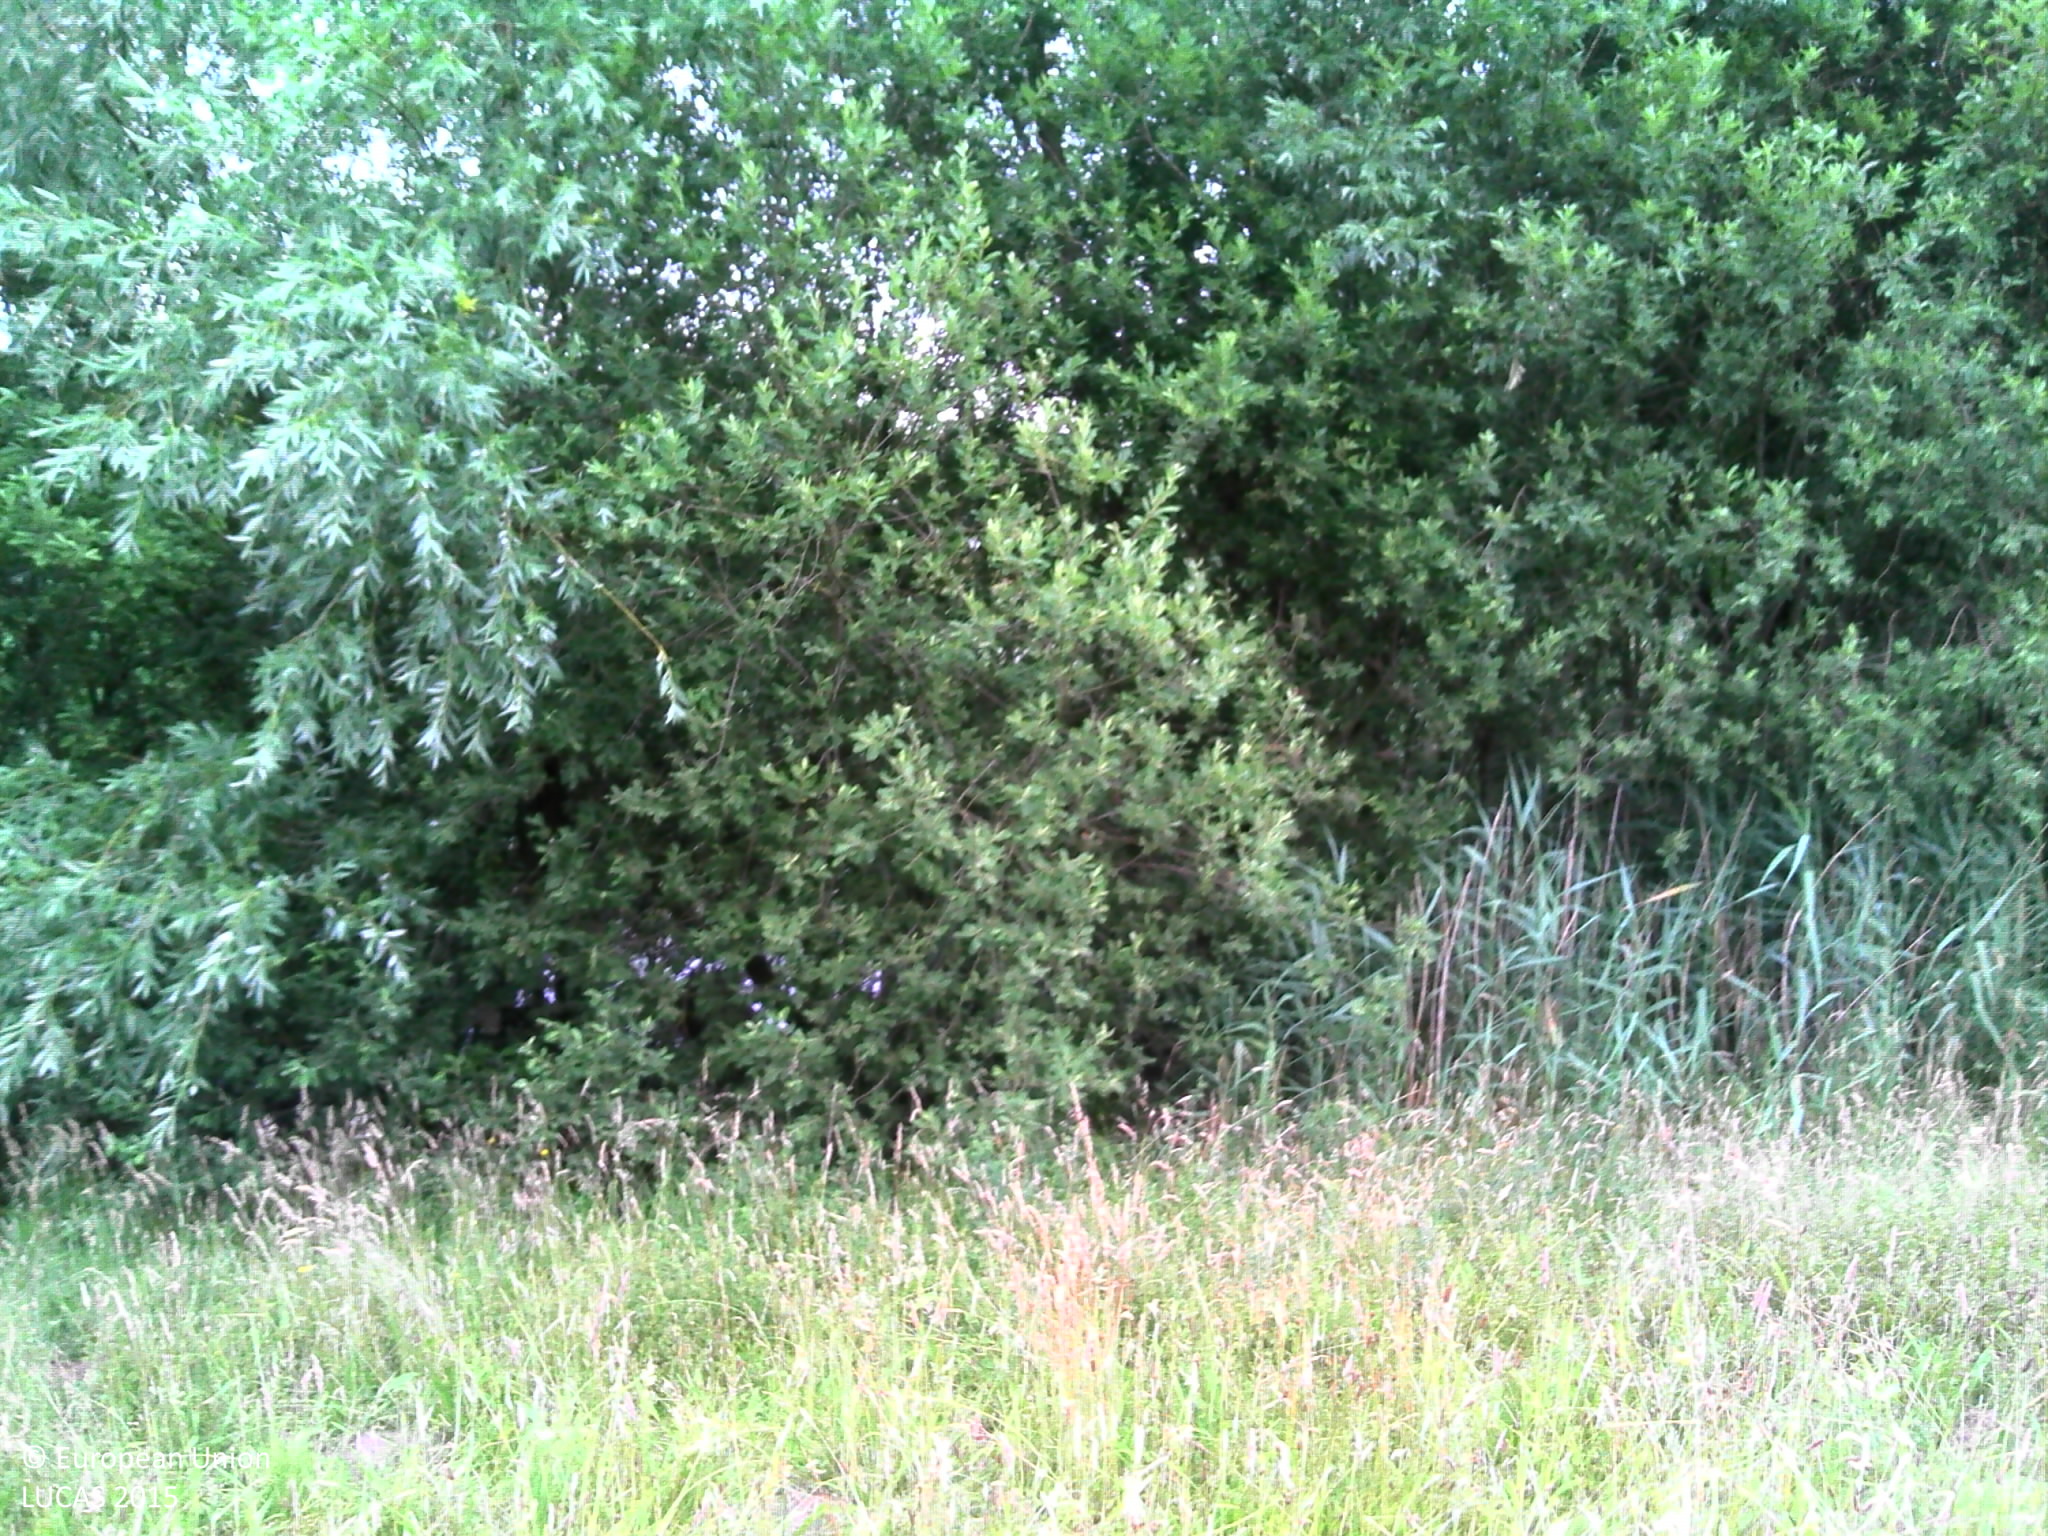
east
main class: Grassland
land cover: Spontaneously vegetated surfaces
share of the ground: > 75 %
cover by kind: herbaceous plants 100 %
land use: Semi-natural and natural areas not in use
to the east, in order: Spontaneously vegetated surfaces; Abandoned hedges; Inland fresh water bodies; Abandoned hedges; Spontaneously vegetated surfaces; Abandoned hedges; Paved roads, cycling and walking lanes; Spontaneously vegetated surfaces; Paved roads, cycling and walking lanes; Spontaneously vegetated surfaces; Ditches and canals; Grass margins; Tracks; Grass margins; Maize; Ditches and canals; Potatoes; Ditches and canals; Fences; Grassland without tree/shrub cover; Fences; Lines of trees; Ditches and canals; Potatoes; Ditches and canals; Potatoes
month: July
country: BE
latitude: 51.2094
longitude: 3.5365
